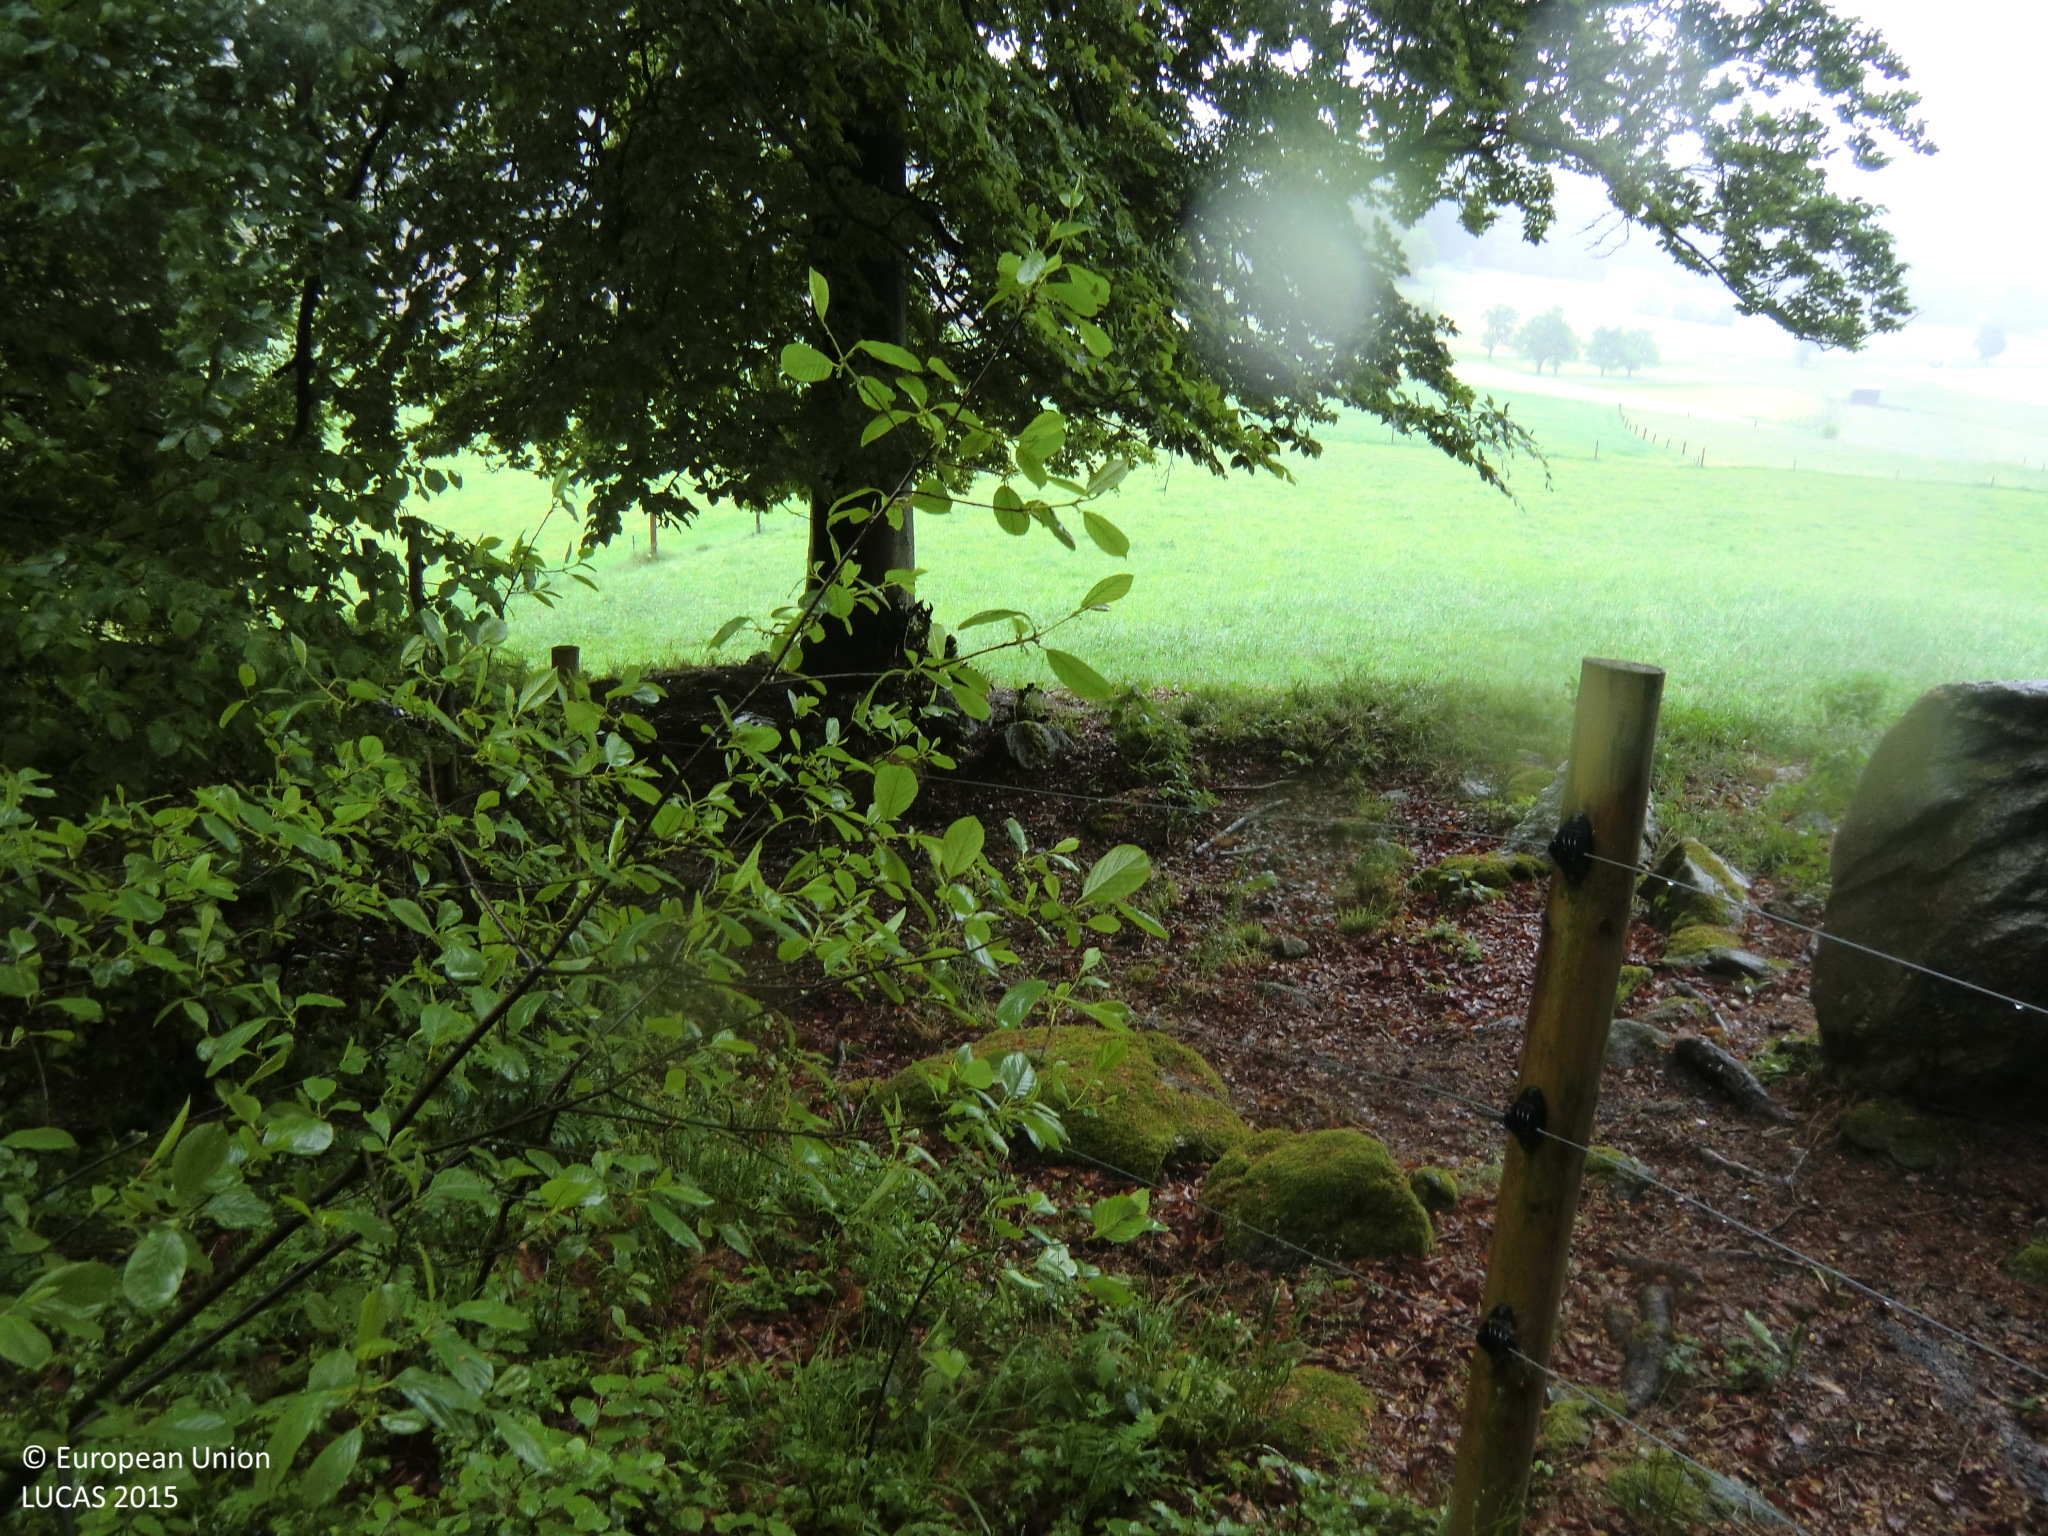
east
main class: Grassland
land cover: Grassland without tree/shrub cover
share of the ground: > 75 %
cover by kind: herbaceous plants 100 %
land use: Agriculture (excluding fallow land and kitchen gardens)
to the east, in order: Grassland without tree/shrub cover; Fences; Grassland without tree/shrub cover; Fences; Common wheat; Grass margins; Paved roads, cycling and walking lanes; Grass margins; Maize; Electric lines; Maize
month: May
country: AT
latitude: 48.4423
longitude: 14.3939
